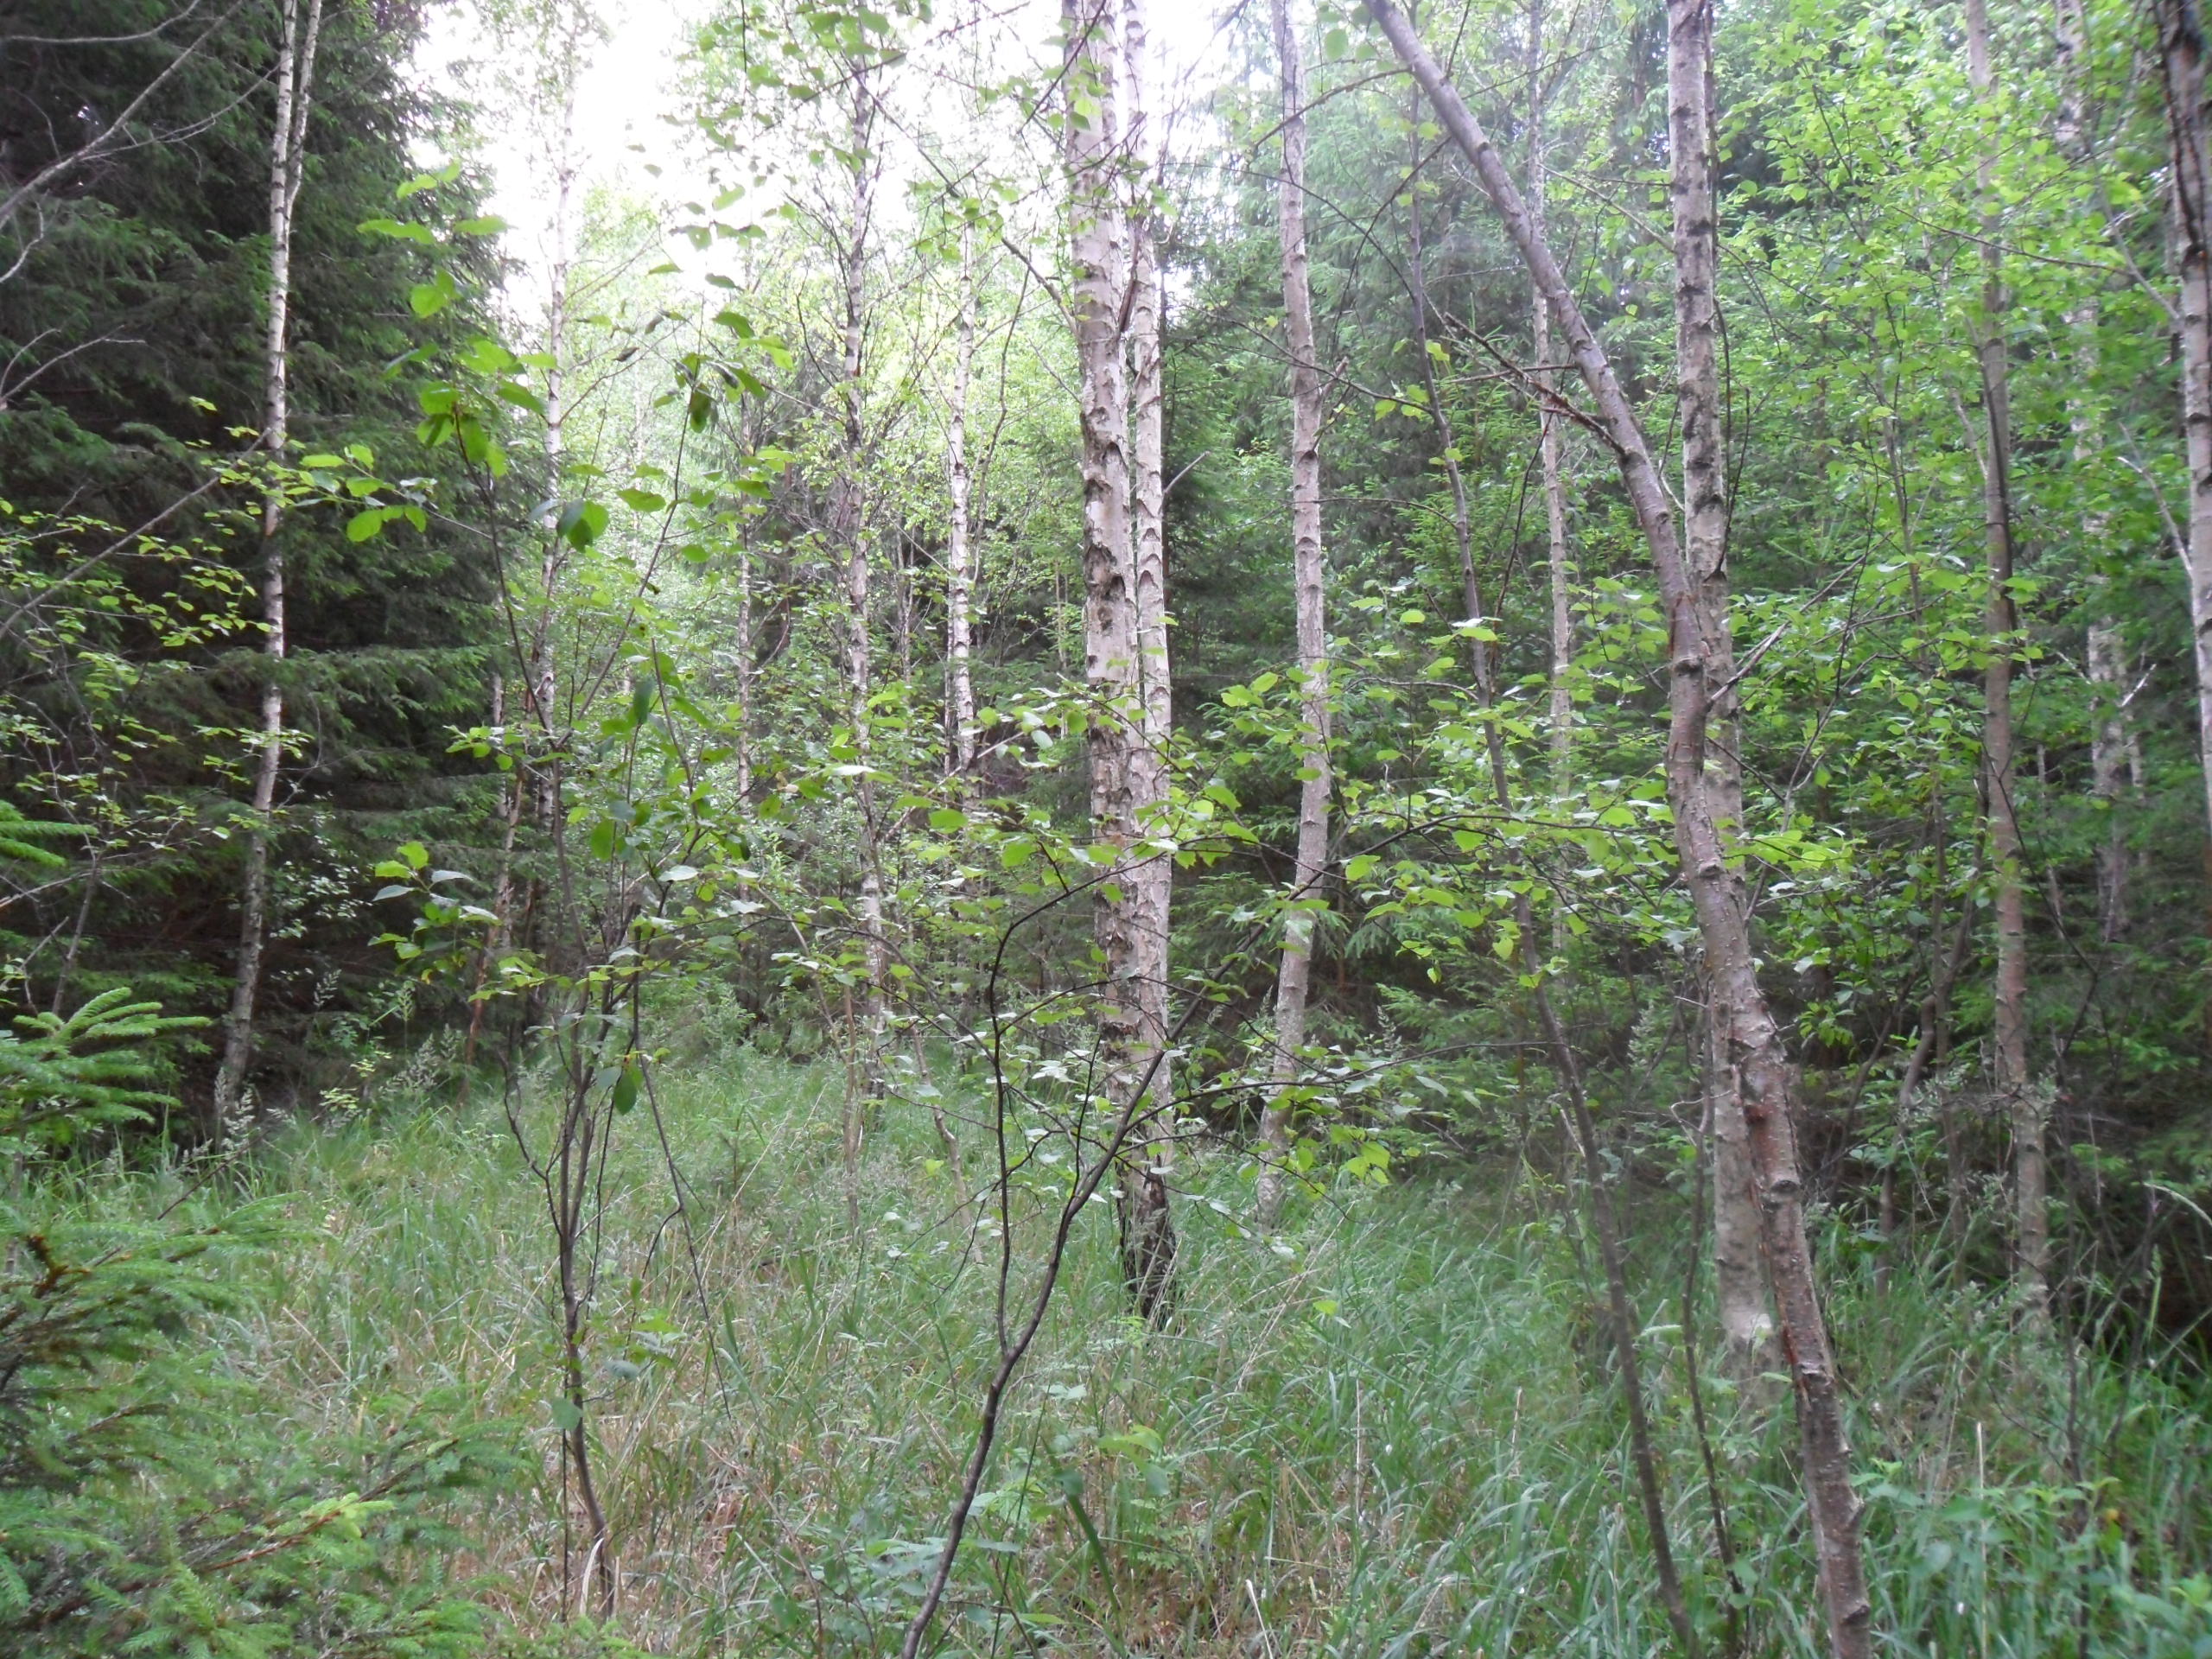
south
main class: Woodland
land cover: Spruce dominated mixed woodland
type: hemiboreal forest and nemoral coniferous forest and mixed broadleaved-coniferous forest
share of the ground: 50 - 75 %
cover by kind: coniferous forest trees 35 %, broadleaved forest trees 35 %, herbaceous plants 20 %, shrubs 10 %
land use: Forestry
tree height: > 5 m
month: July
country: LV
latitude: 57.1409
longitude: 22.4979
